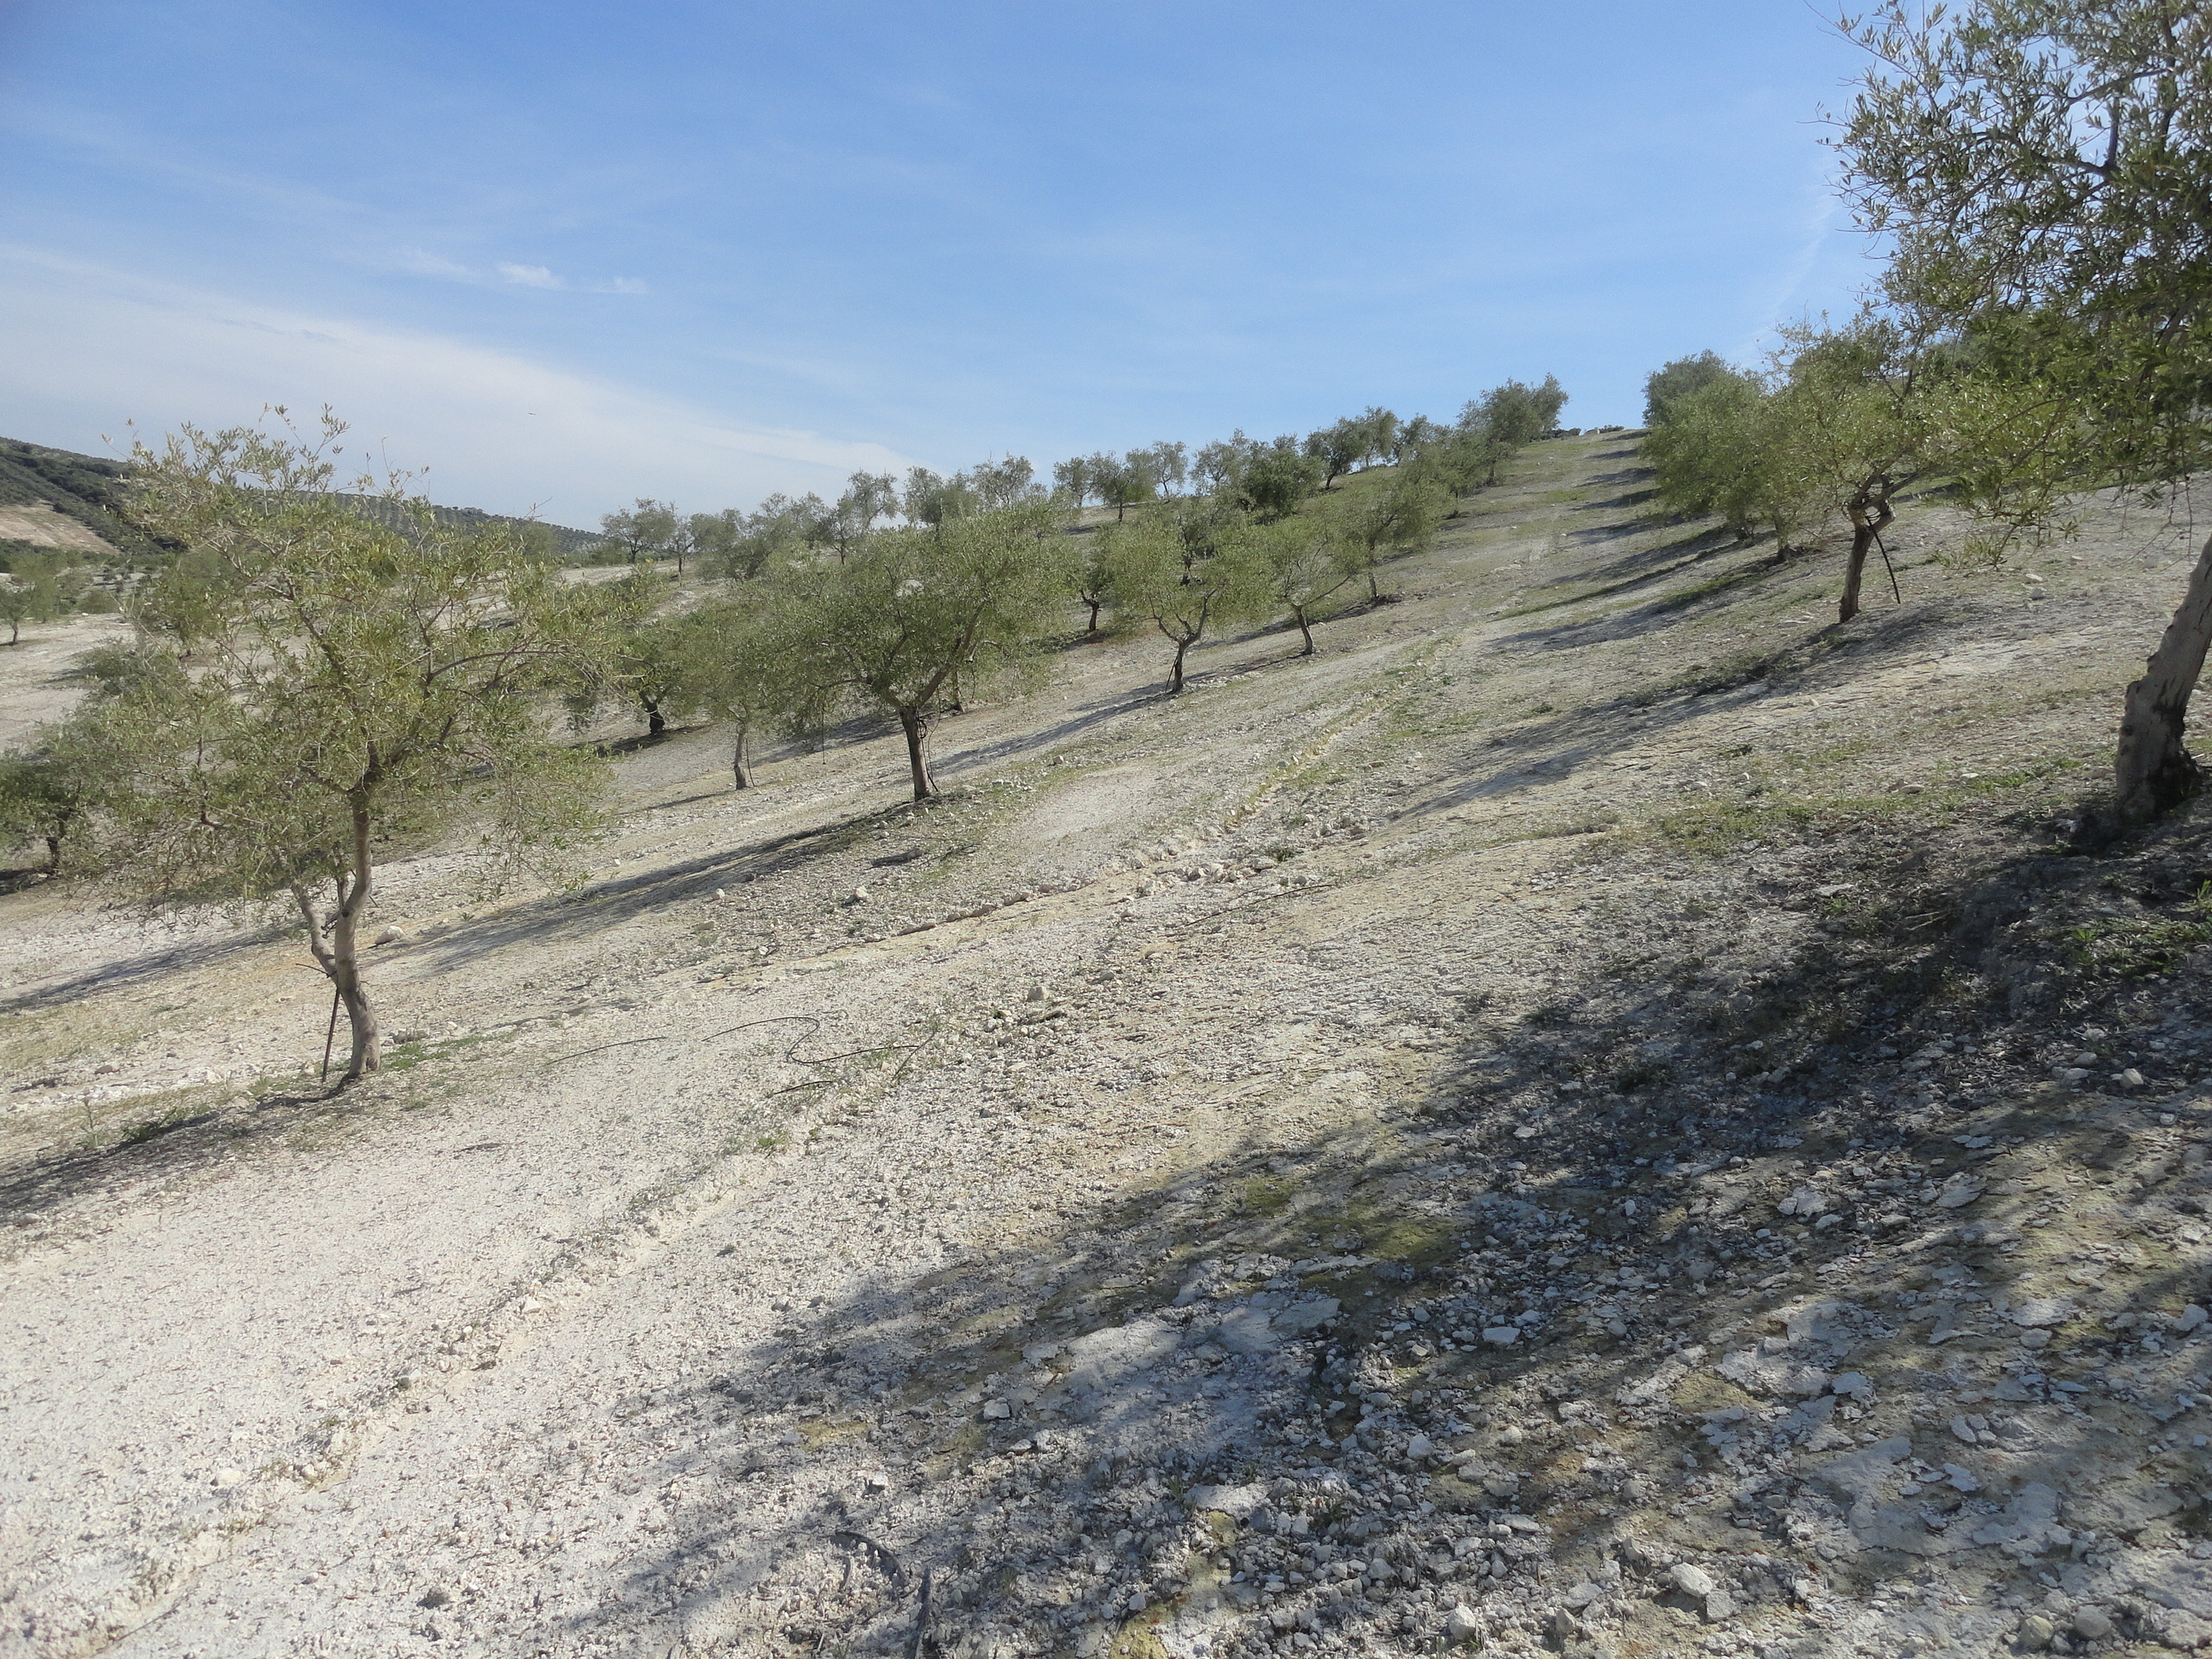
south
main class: Cropland
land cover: Olive groves
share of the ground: 25 - 50 %
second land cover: Other bare soil
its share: > 75 %
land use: Agriculture (excluding fallow land and kitchen gardens)
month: April
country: ES
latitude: 37.6477
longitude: -4.4570
